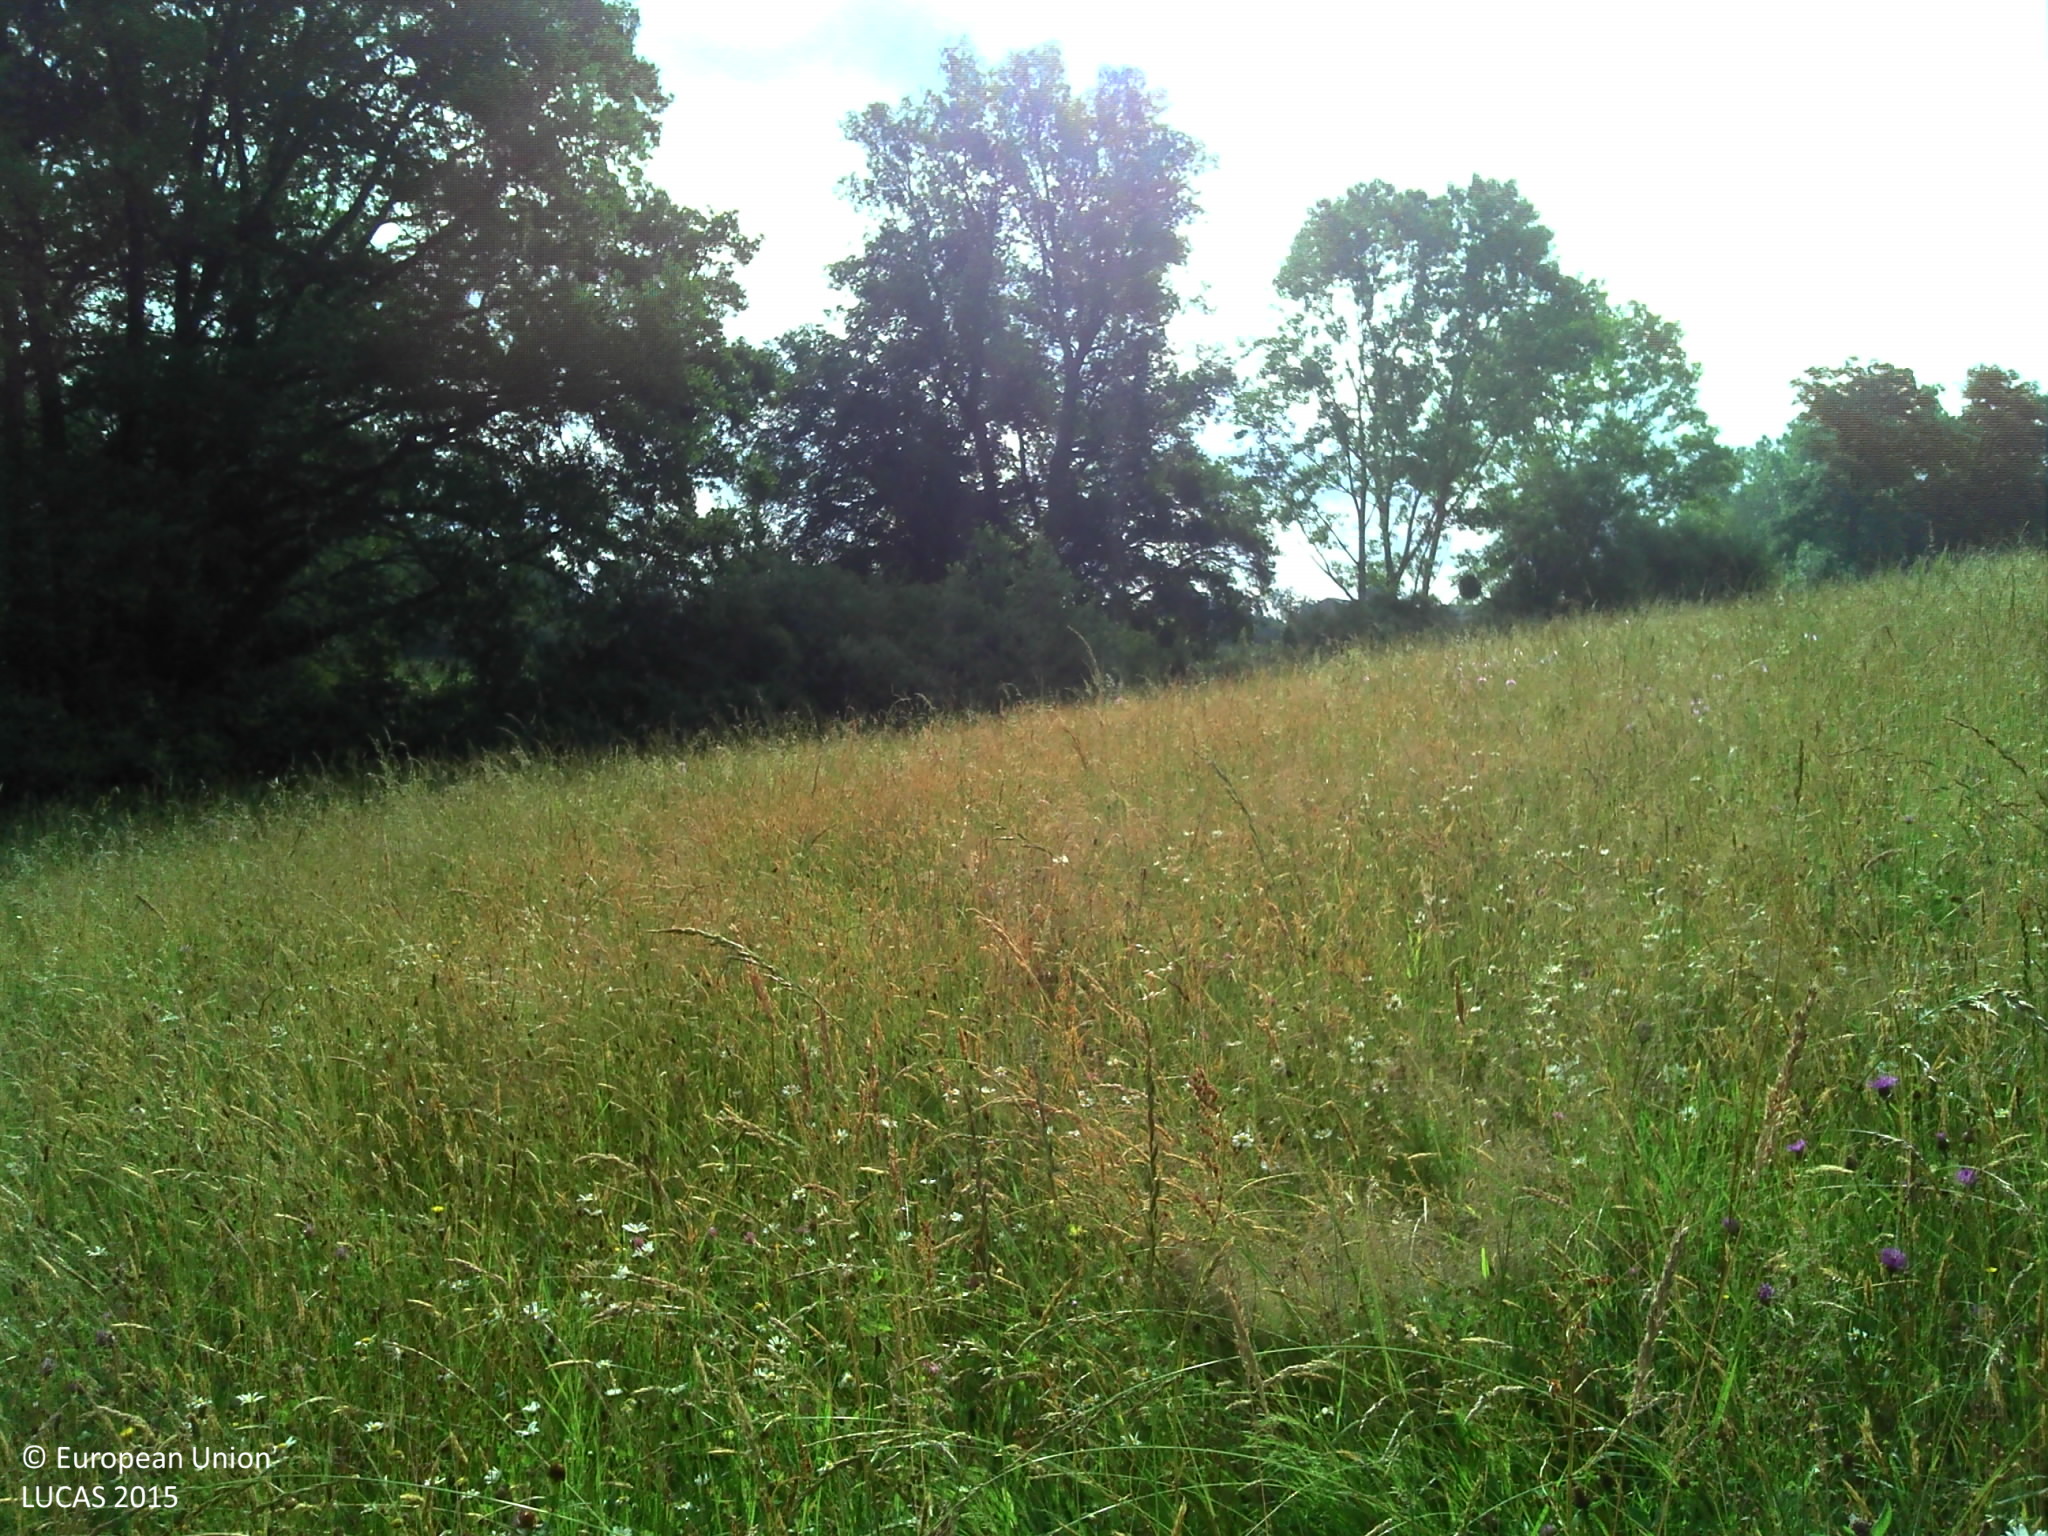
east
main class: Grassland
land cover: Grassland without tree/shrub cover
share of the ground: > 75 %
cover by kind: herbaceous plants 100 %
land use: Agriculture (excluding fallow land and kitchen gardens)
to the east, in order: Grassland without tree/shrub cover; Fences; Shrubland with sparse tree cover; Broadleaved woodland; Fences; Grassland with sparse tree/shrub cover; Grassland without tree/shrub cover; Fences; Grassland without tree/shrub cover
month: June
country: FR
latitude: 44.2087
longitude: 2.0552
